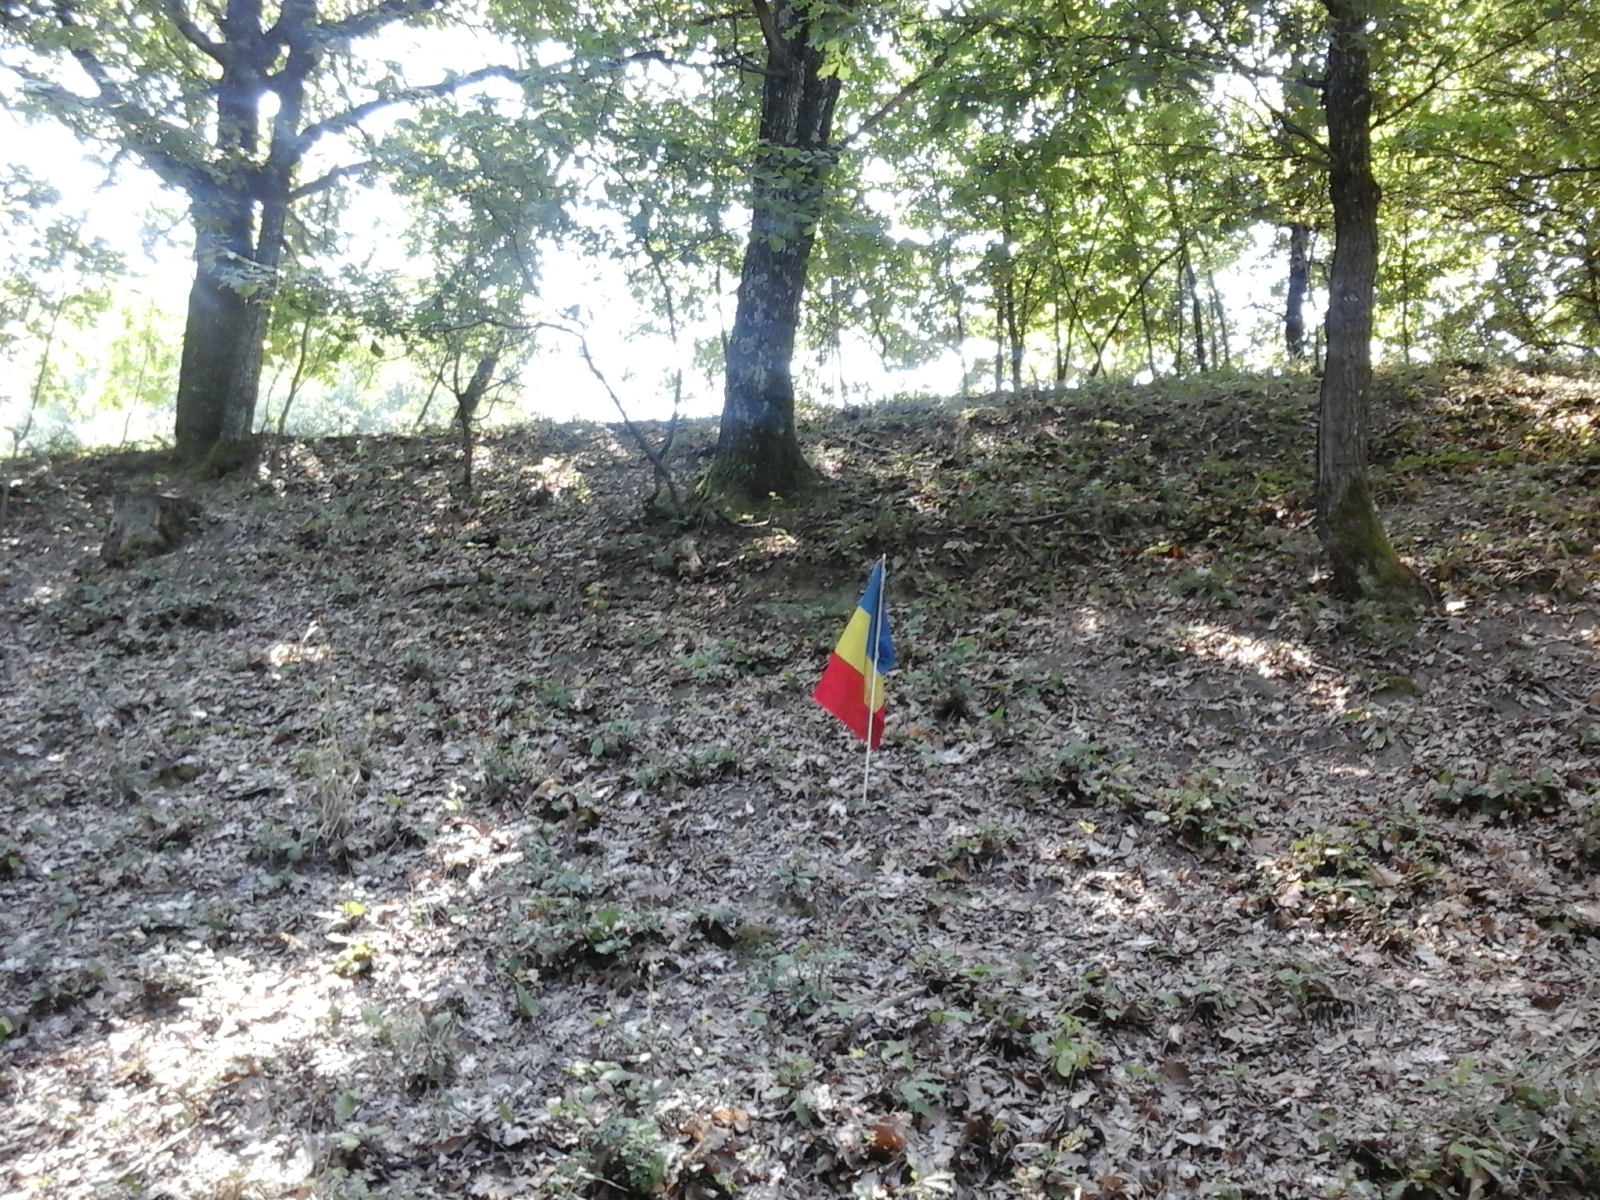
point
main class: Woodland
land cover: Broadleaved woodland
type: acidophilous oak and oak-birch forest
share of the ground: > 75 %
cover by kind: broadleaved forest trees 100 %
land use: Forestry
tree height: > 5 m
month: August
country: RO
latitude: 44.8755
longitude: 23.8731
